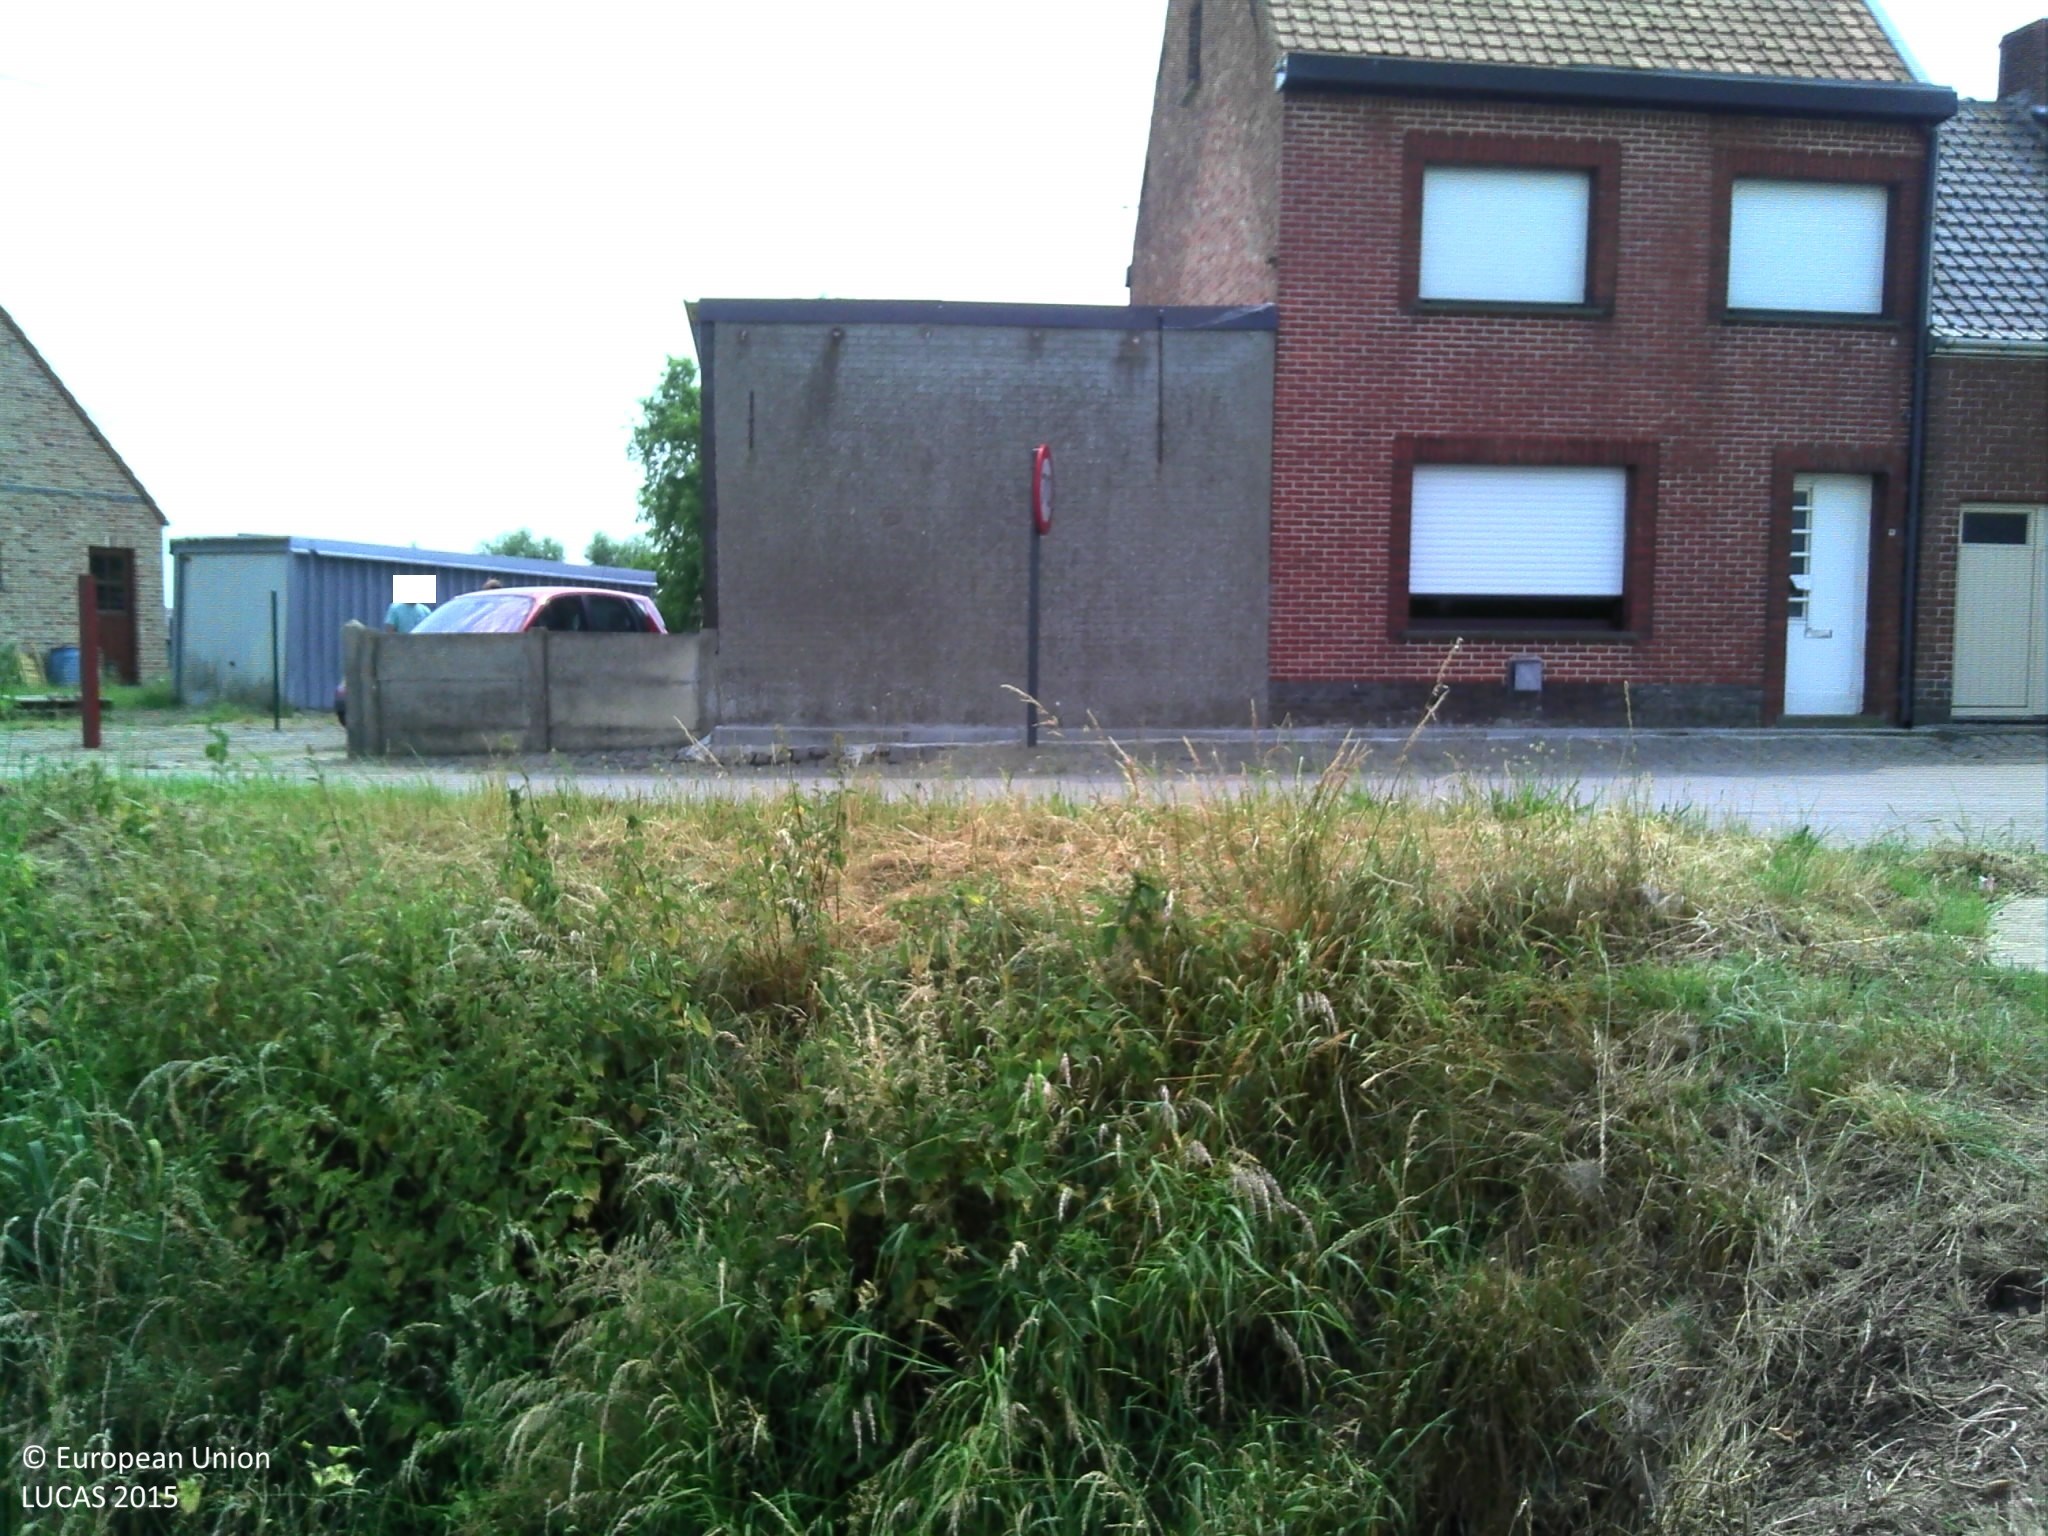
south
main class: Grassland
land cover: Grassland without tree/shrub cover
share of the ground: > 75 %
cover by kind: herbaceous plants 100 %
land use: Agriculture (excluding fallow land and kitchen gardens)
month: July
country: BE
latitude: 51.2873
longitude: 3.6407
